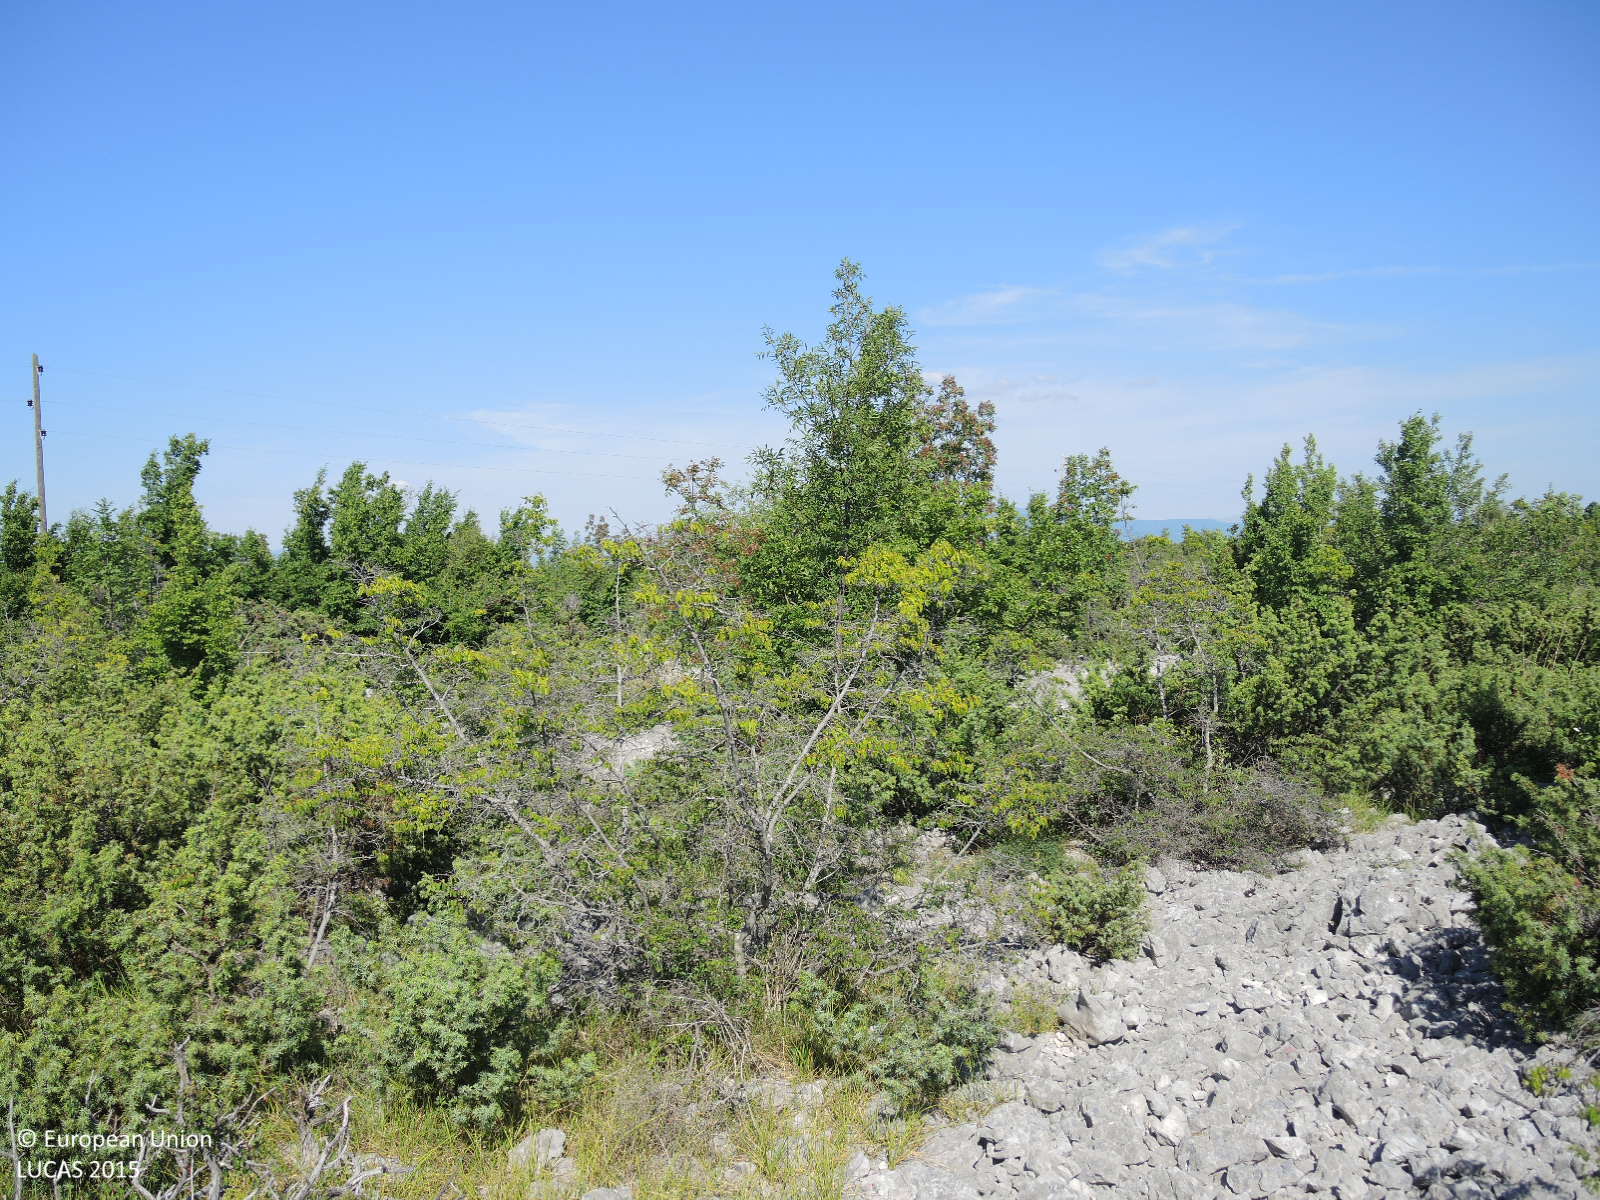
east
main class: Shrubland
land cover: Shrubland with sparse tree cover
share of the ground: 50 - 75 %
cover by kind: shrubs 50 %, unconsolidated bare surface 30 %, herbaceous plants 10 %, broadleaved forest trees 5 %, consolidated bare surface 5 %
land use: Semi-natural and natural areas not in use
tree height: < 5 m
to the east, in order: Shrubland with sparse tree cover; Electric lines; Shrubland with sparse tree cover; Tracks; Shrubland with sparse tree cover
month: May
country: HR
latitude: 43.9290
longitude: 15.9084
